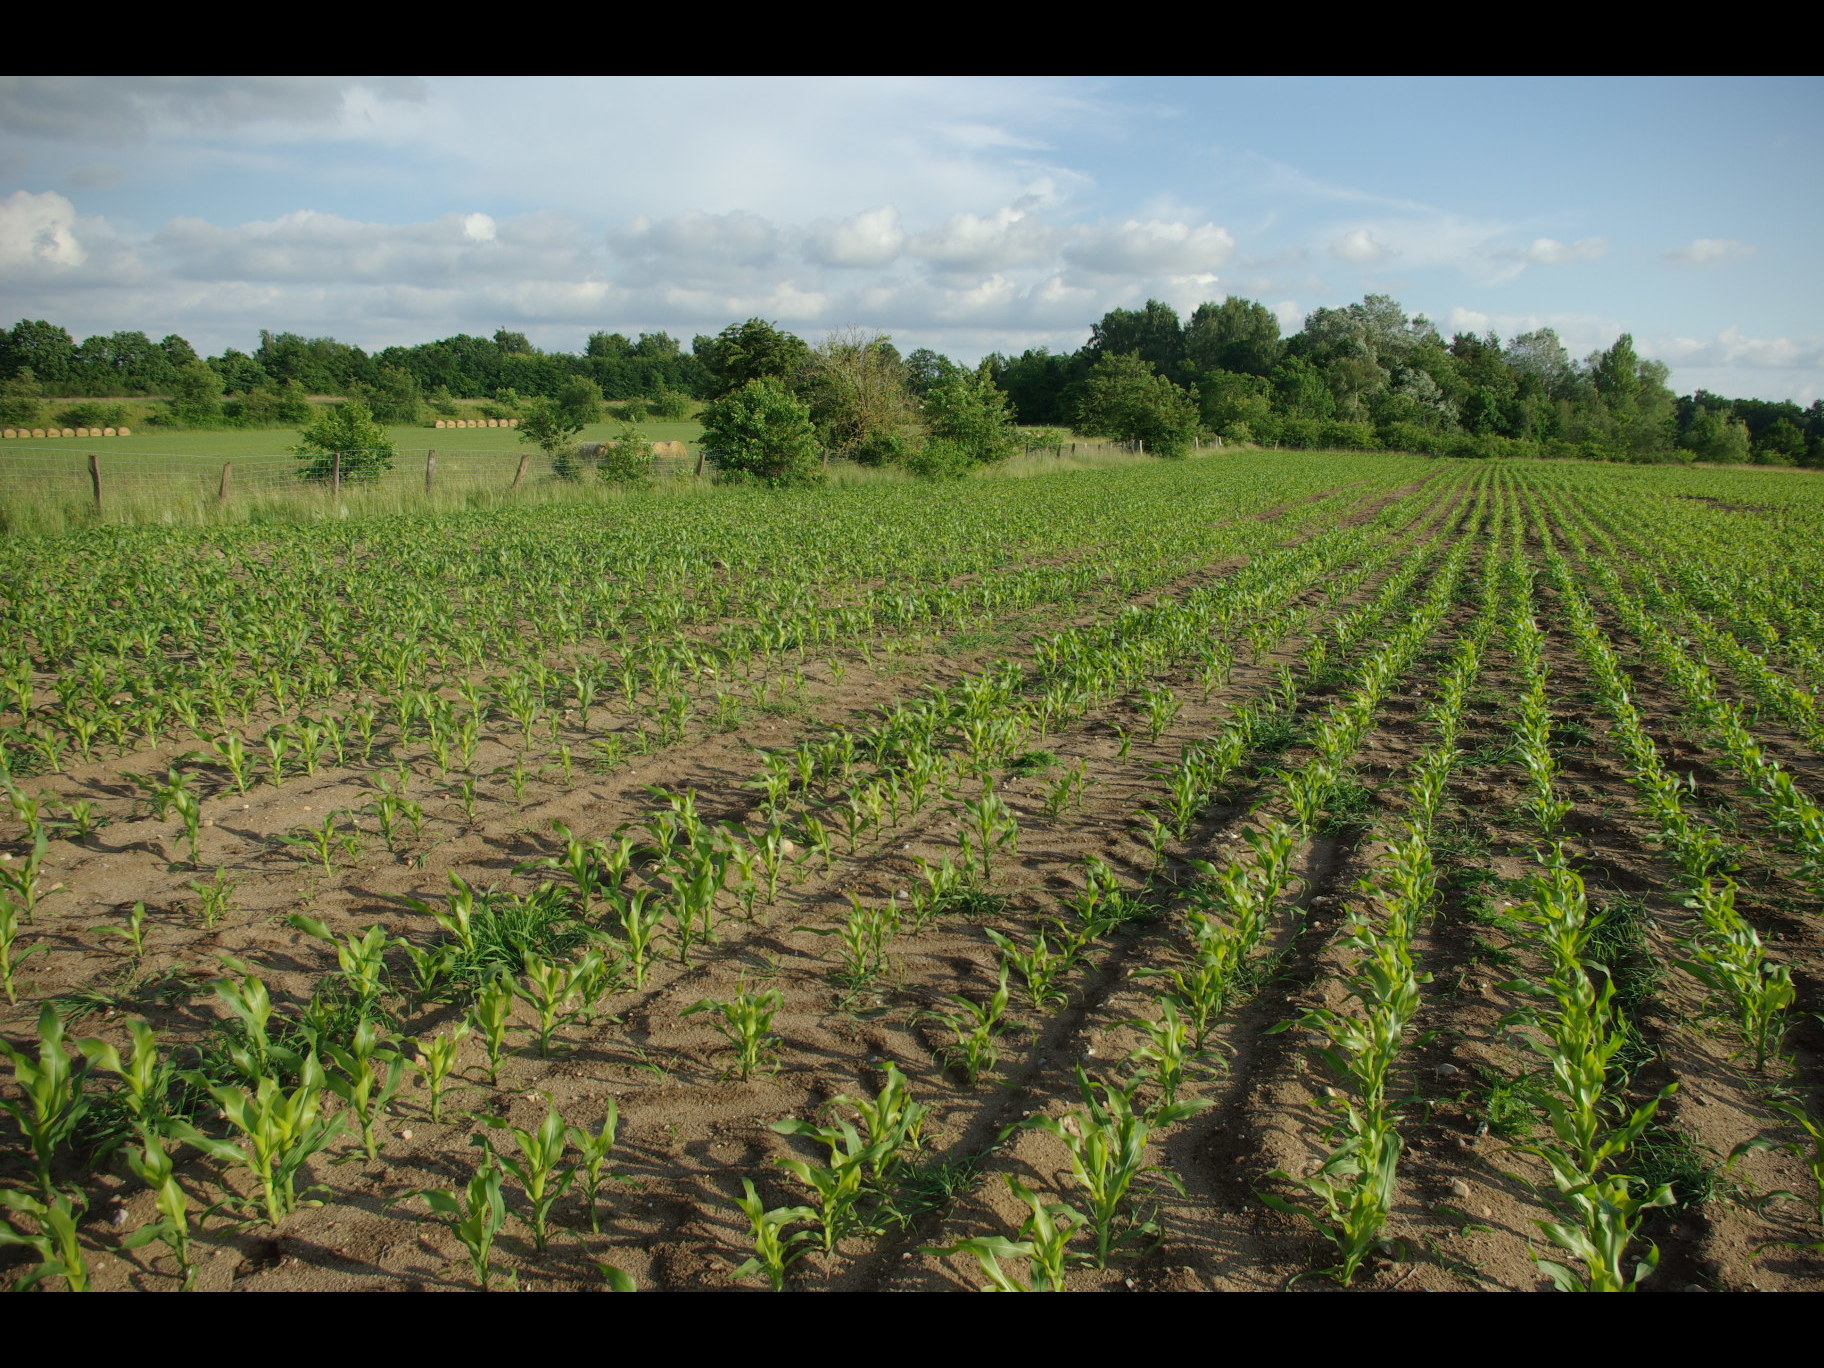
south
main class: Cropland
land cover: Maize
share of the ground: 25 - 50 %
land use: Agriculture (excluding fallow land and kitchen gardens)
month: June
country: DE
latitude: 54.2106
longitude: 9.8927
